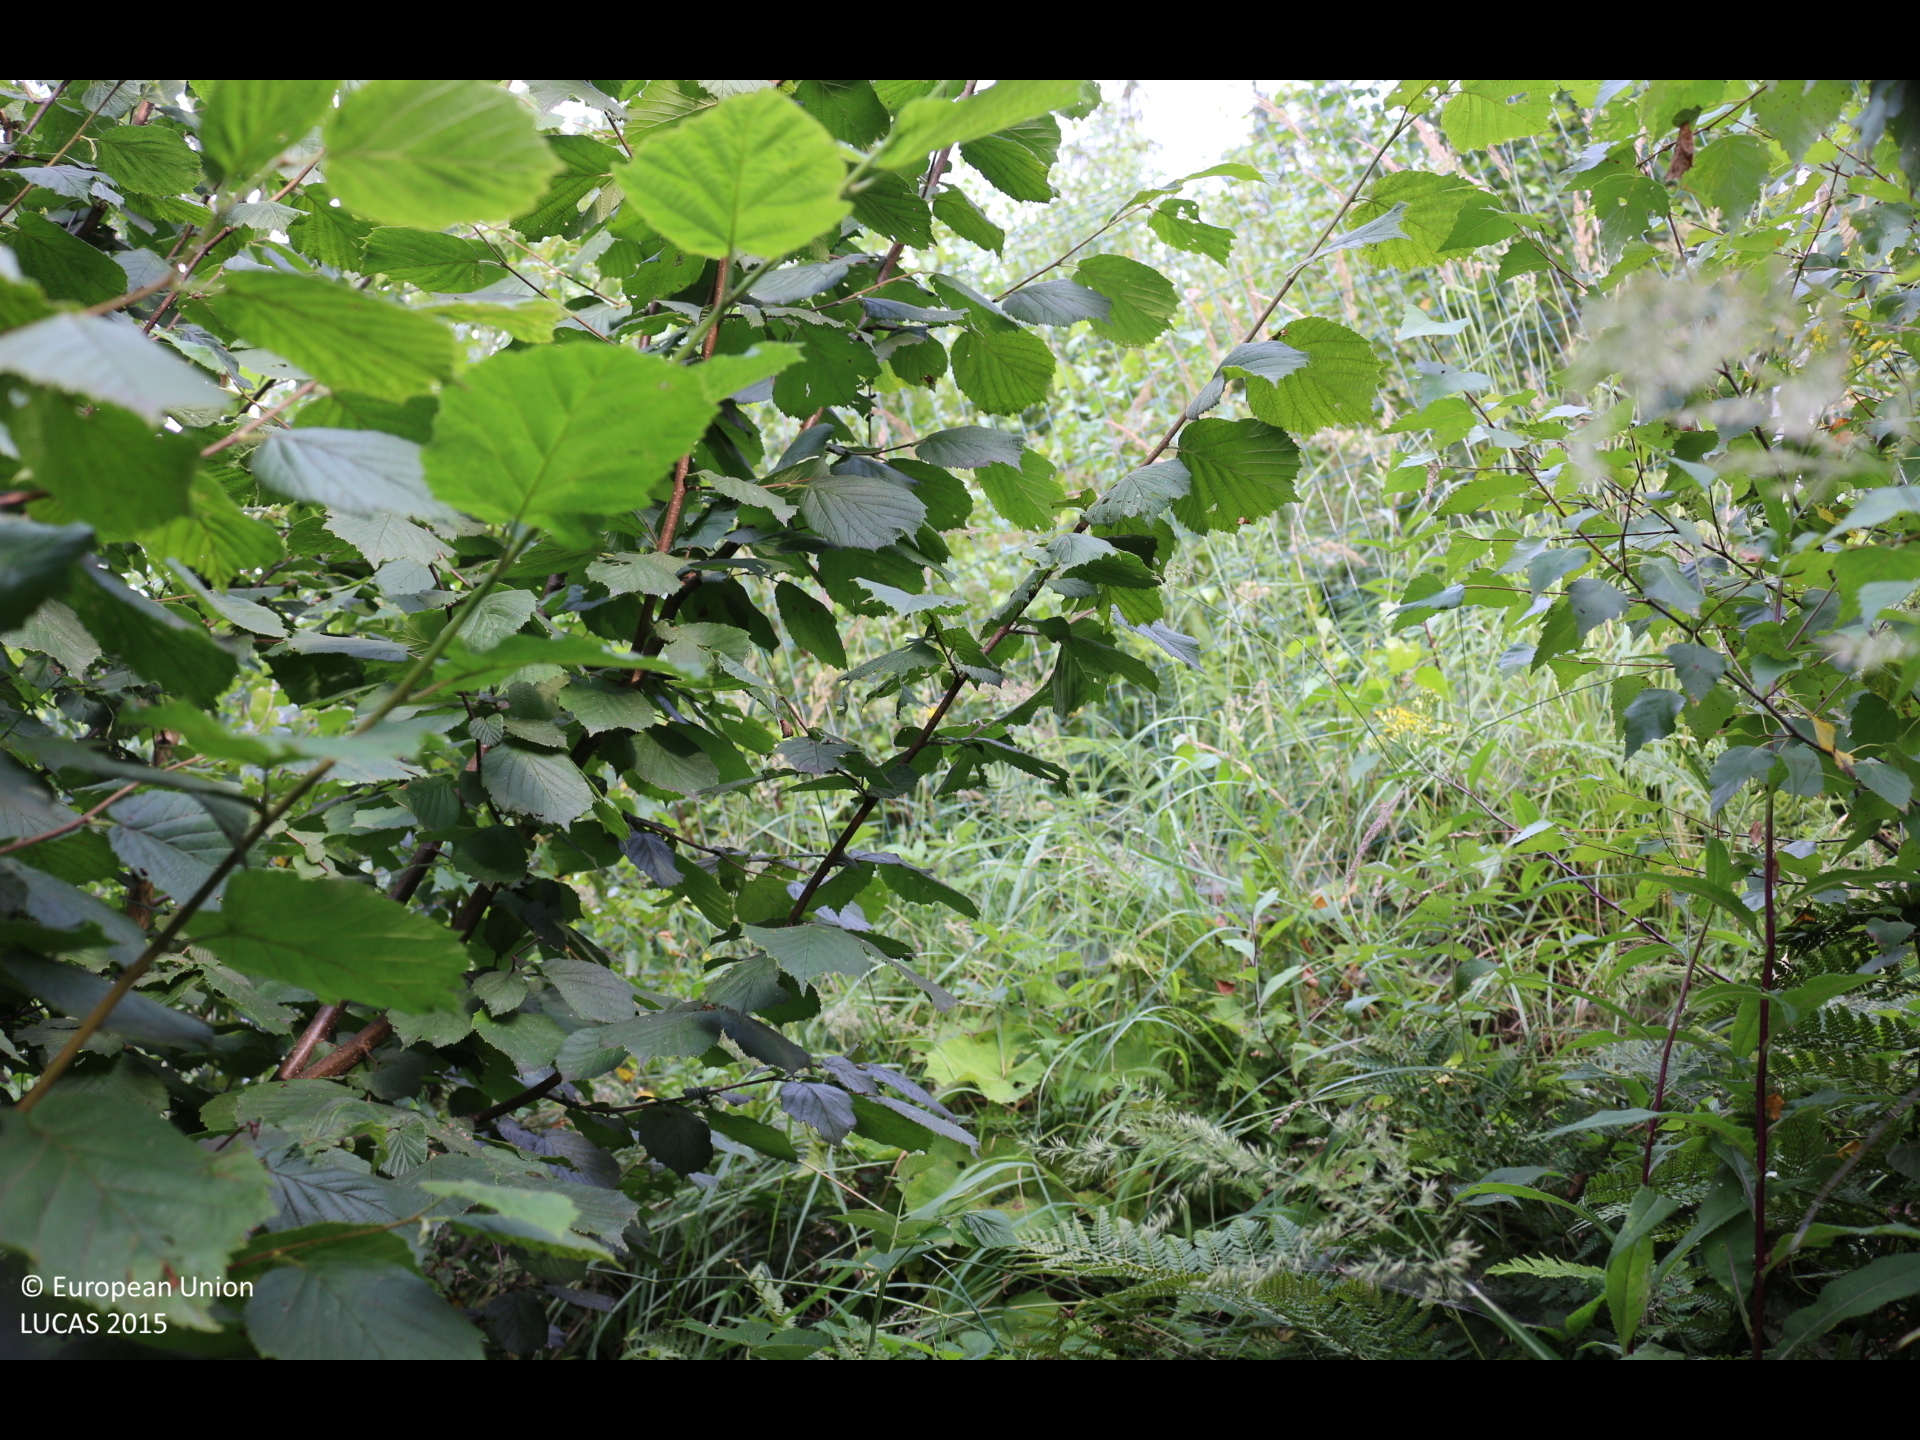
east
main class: Shrubland
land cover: Shrubland with sparse tree cover
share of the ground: > 75 %
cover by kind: shrubs 80 %, herbaceous plants 15 %, broadleaved forest trees 5 %
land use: Forestry
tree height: < 5 m
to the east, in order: Shrubland with sparse tree cover; Fences; Shrubland with sparse tree cover; Tracks; Shrubland with sparse tree cover; Artificial constructions; Paved roads, cycling and walking lanes; Broadleaved woodland; Ditches and canals; Shrubland with sparse tree cover; Artificial constructions in urban areas; Inland fresh running water; Broadleaved woodland; Spruce dominated mixed woodland
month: July
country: AT
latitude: 46.8168
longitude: 13.4969
